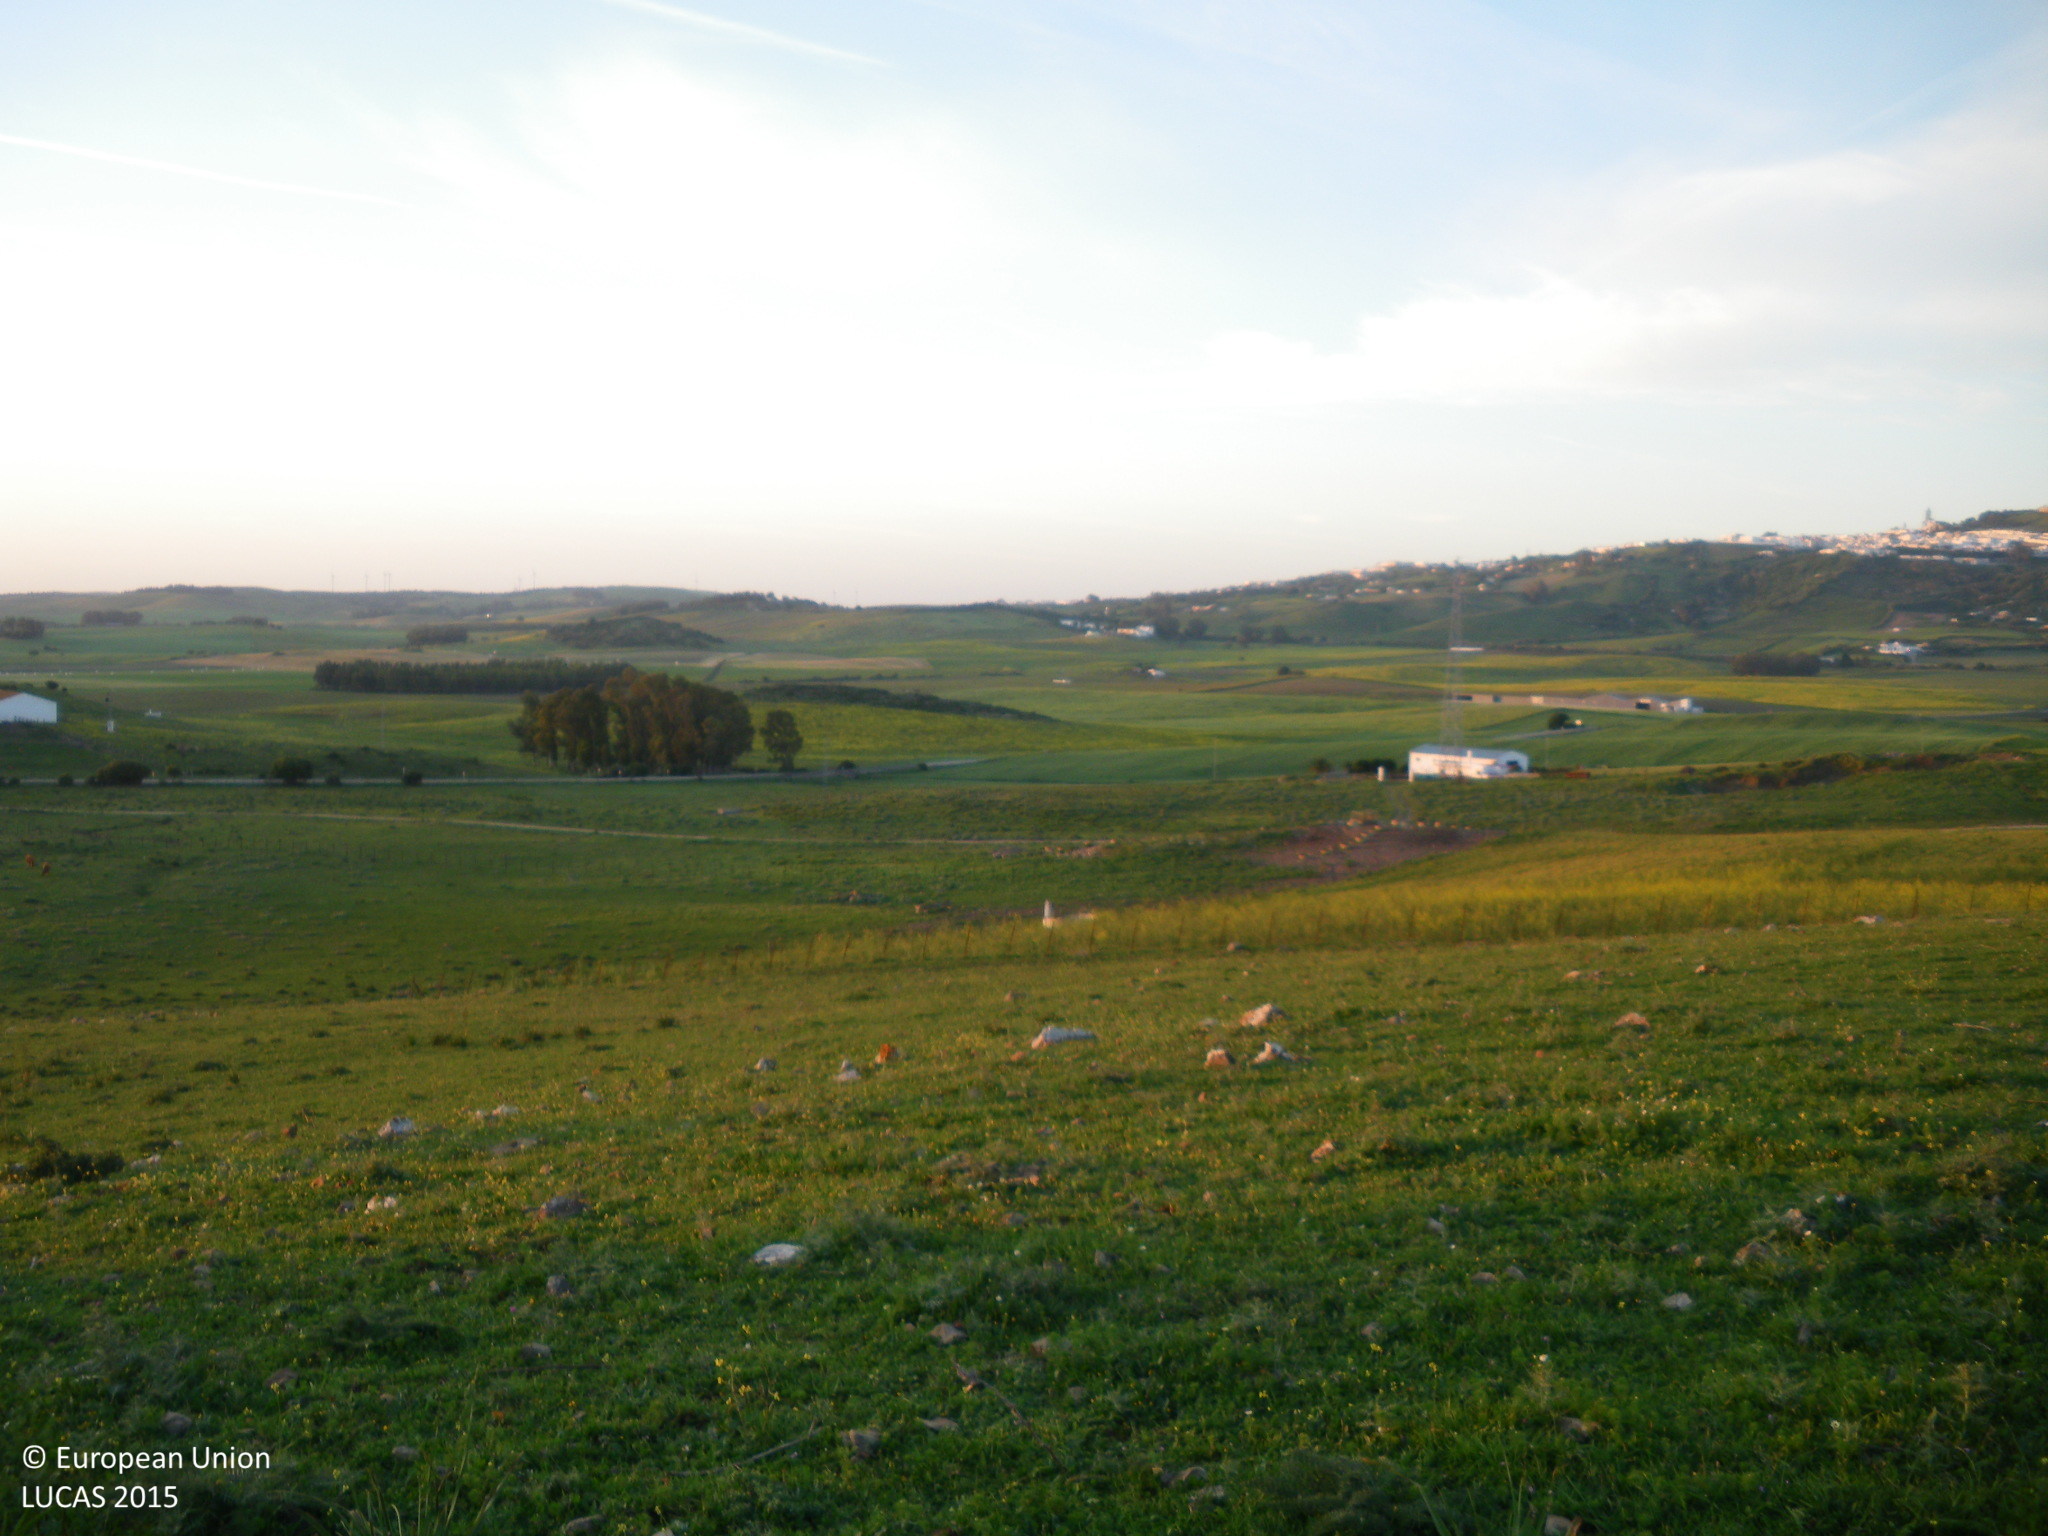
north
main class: Grassland
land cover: Grassland without tree/shrub cover
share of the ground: > 75 %
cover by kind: herbaceous plants 95 %, unconsolidated bare surface 5 %
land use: Agriculture (excluding fallow land and kitchen gardens)
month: April
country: ES
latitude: 36.4299
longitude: -5.9436
